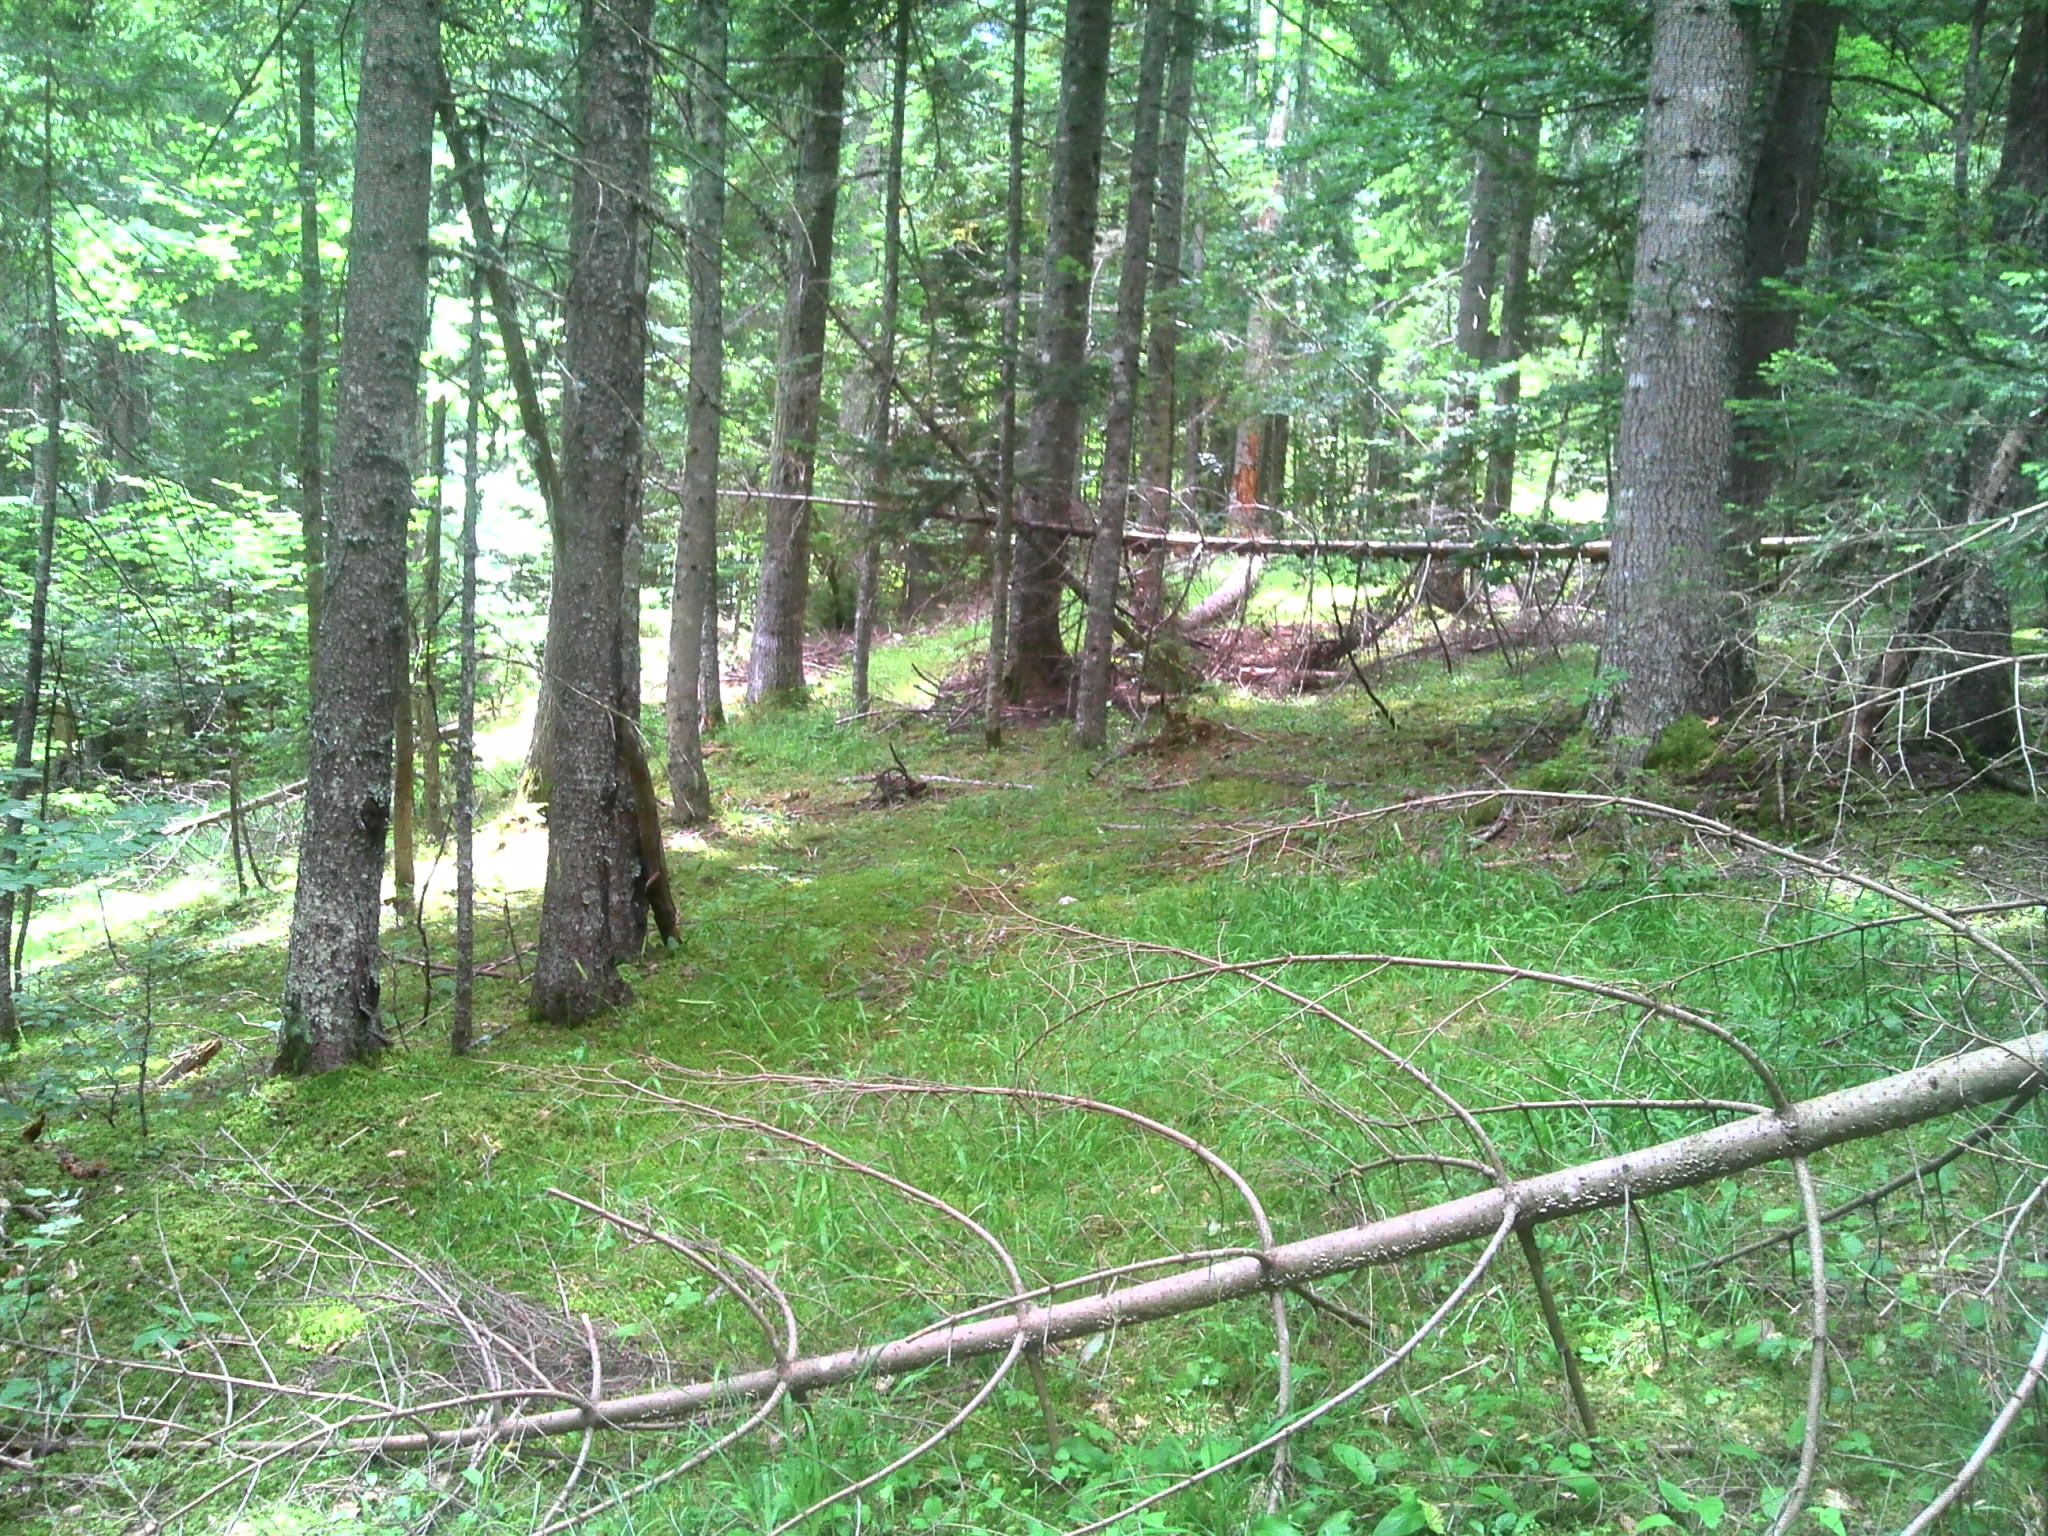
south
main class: Woodland
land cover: Spruce dominated coniferous woodland
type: alpine coniferous forest
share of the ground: > 75 %
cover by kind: coniferous forest trees 75 %, broadleaved forest trees 10 %, herbaceous plants 10 %, lichens and mosses 5 %
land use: Forestry
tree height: > 5 m
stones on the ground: < 10 %
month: July
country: FR
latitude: 45.1036
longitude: 5.5448
